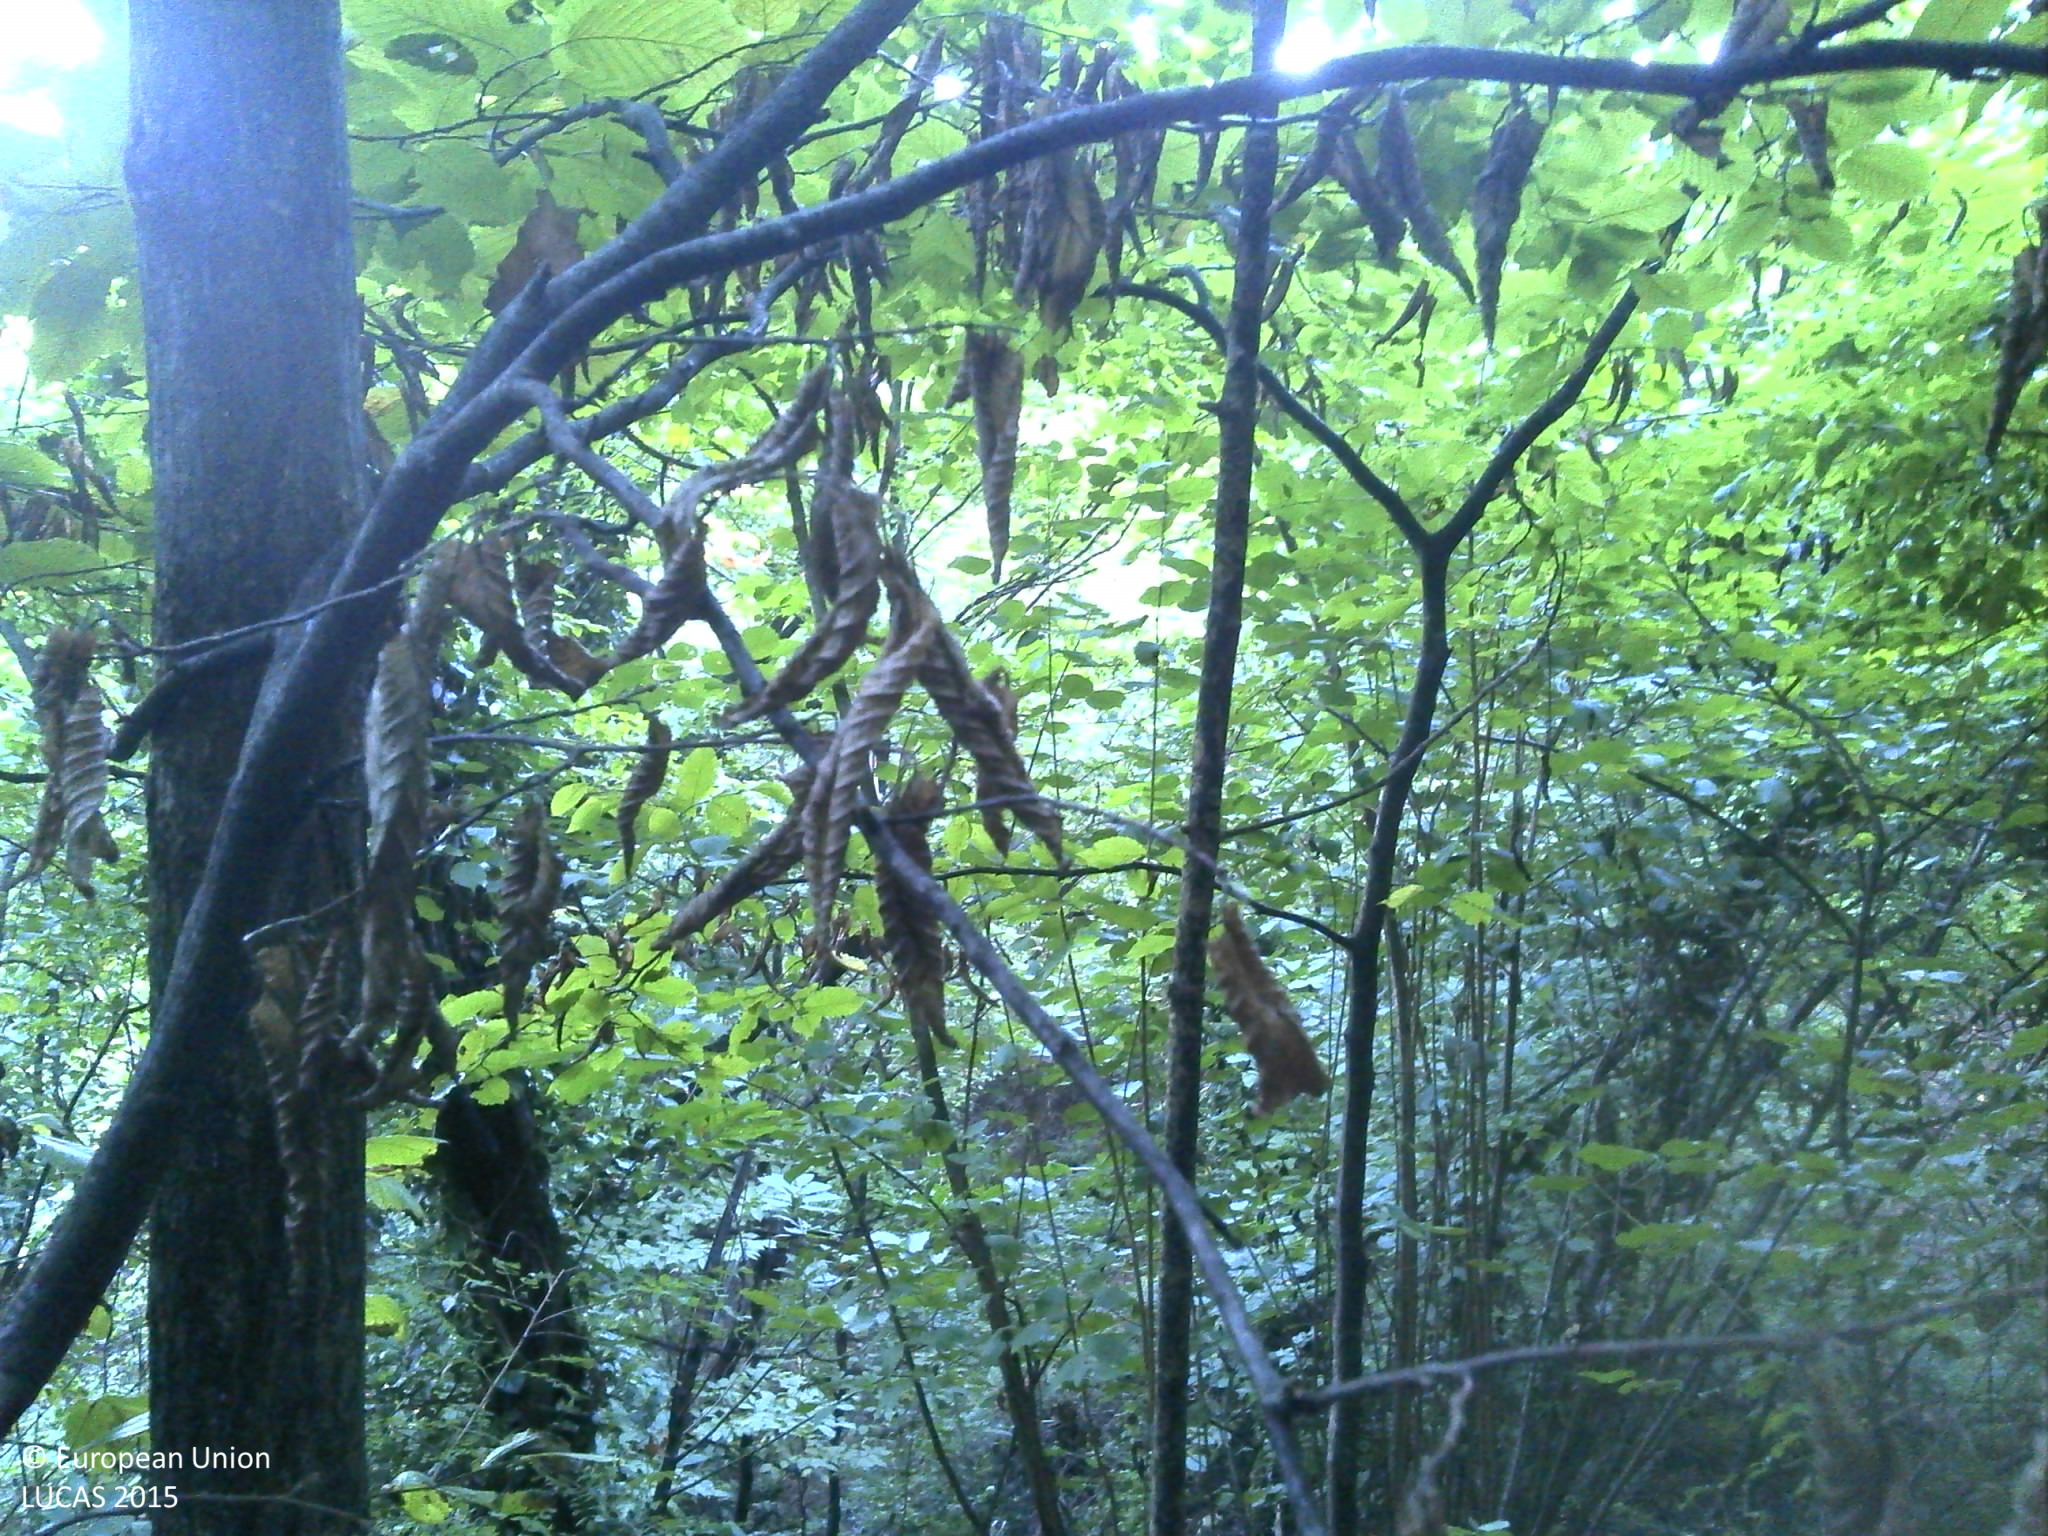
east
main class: Woodland
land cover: Broadleaved woodland
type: acidophilous oak and oak-birch forest
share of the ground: > 75 %
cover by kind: broadleaved forest trees 100 %
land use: Forestry
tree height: > 5 m
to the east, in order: Broadleaved woodland; Grassland without tree/shrub cover; Shrubland with sparse tree cover; Tracks; Grassland with sparse tree/shrub cover; Other fruit trees and berries
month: August
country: HR
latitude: 45.2586
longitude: 16.3560
